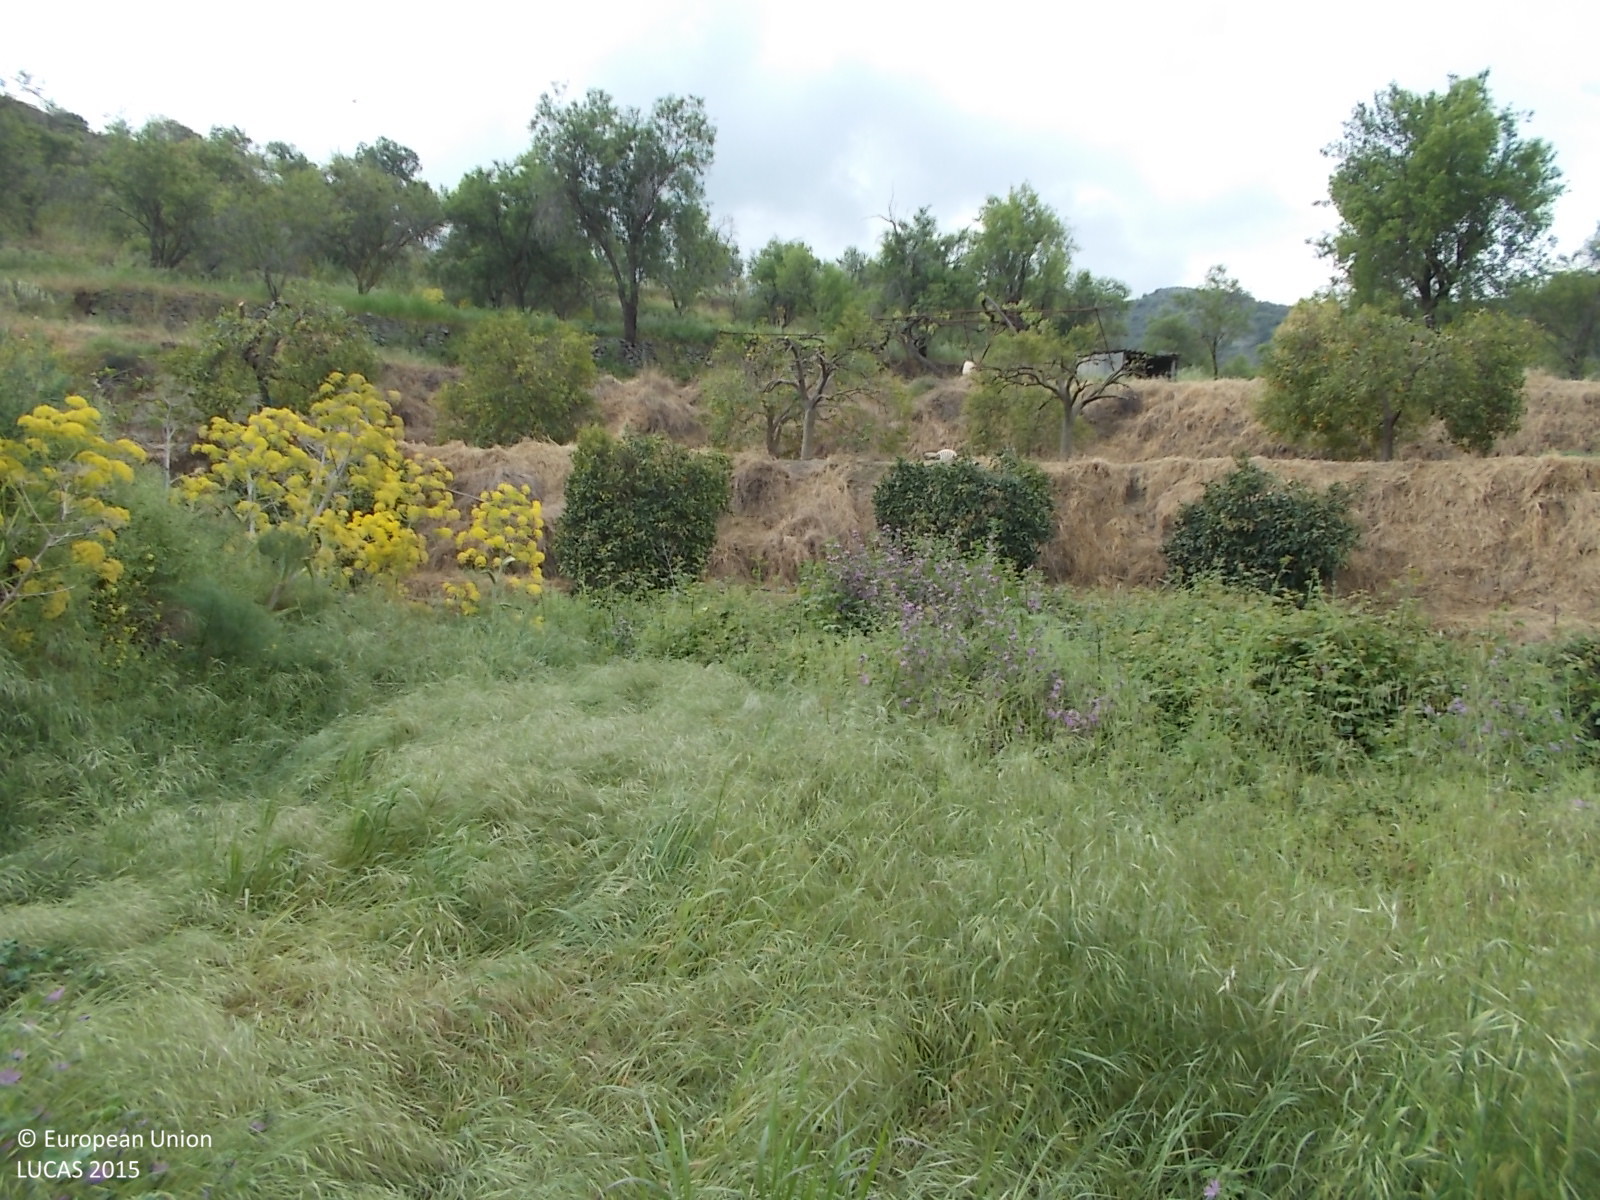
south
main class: Grassland
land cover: Spontaneously vegetated surfaces
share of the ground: > 75 %
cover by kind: herbaceous plants 100 %
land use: Fallow land
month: April
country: CY
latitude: 34.8140
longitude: 33.1414
